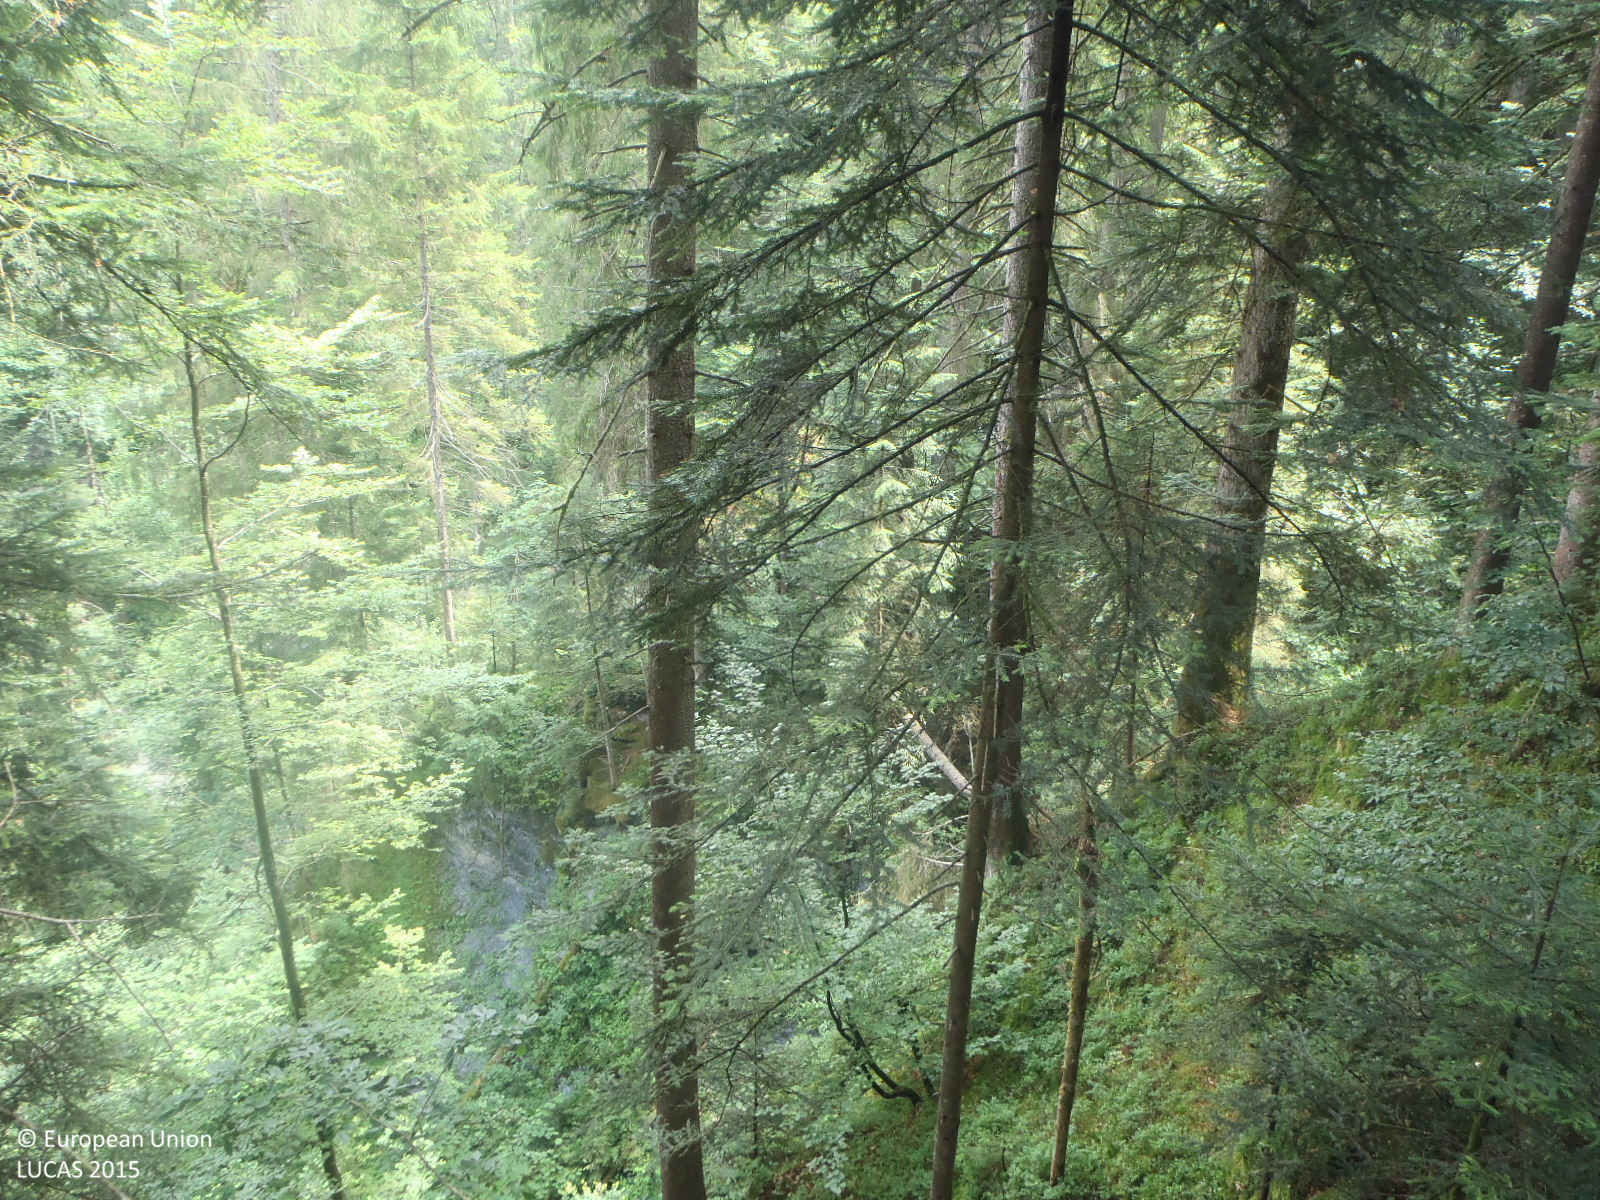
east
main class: Woodland
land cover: Spruce dominated mixed woodland
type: alpine coniferous forest
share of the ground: > 75 %
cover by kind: coniferous forest trees 60 %, broadleaved forest trees 25 %, shrubs 10 %, lichens and mosses 5 %
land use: Forestry
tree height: > 5 m
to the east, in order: Spruce dominated mixed woodland; Inland fresh running water; Spruce dominated mixed woodland
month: July
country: AT
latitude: 47.4092
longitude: 12.2115
